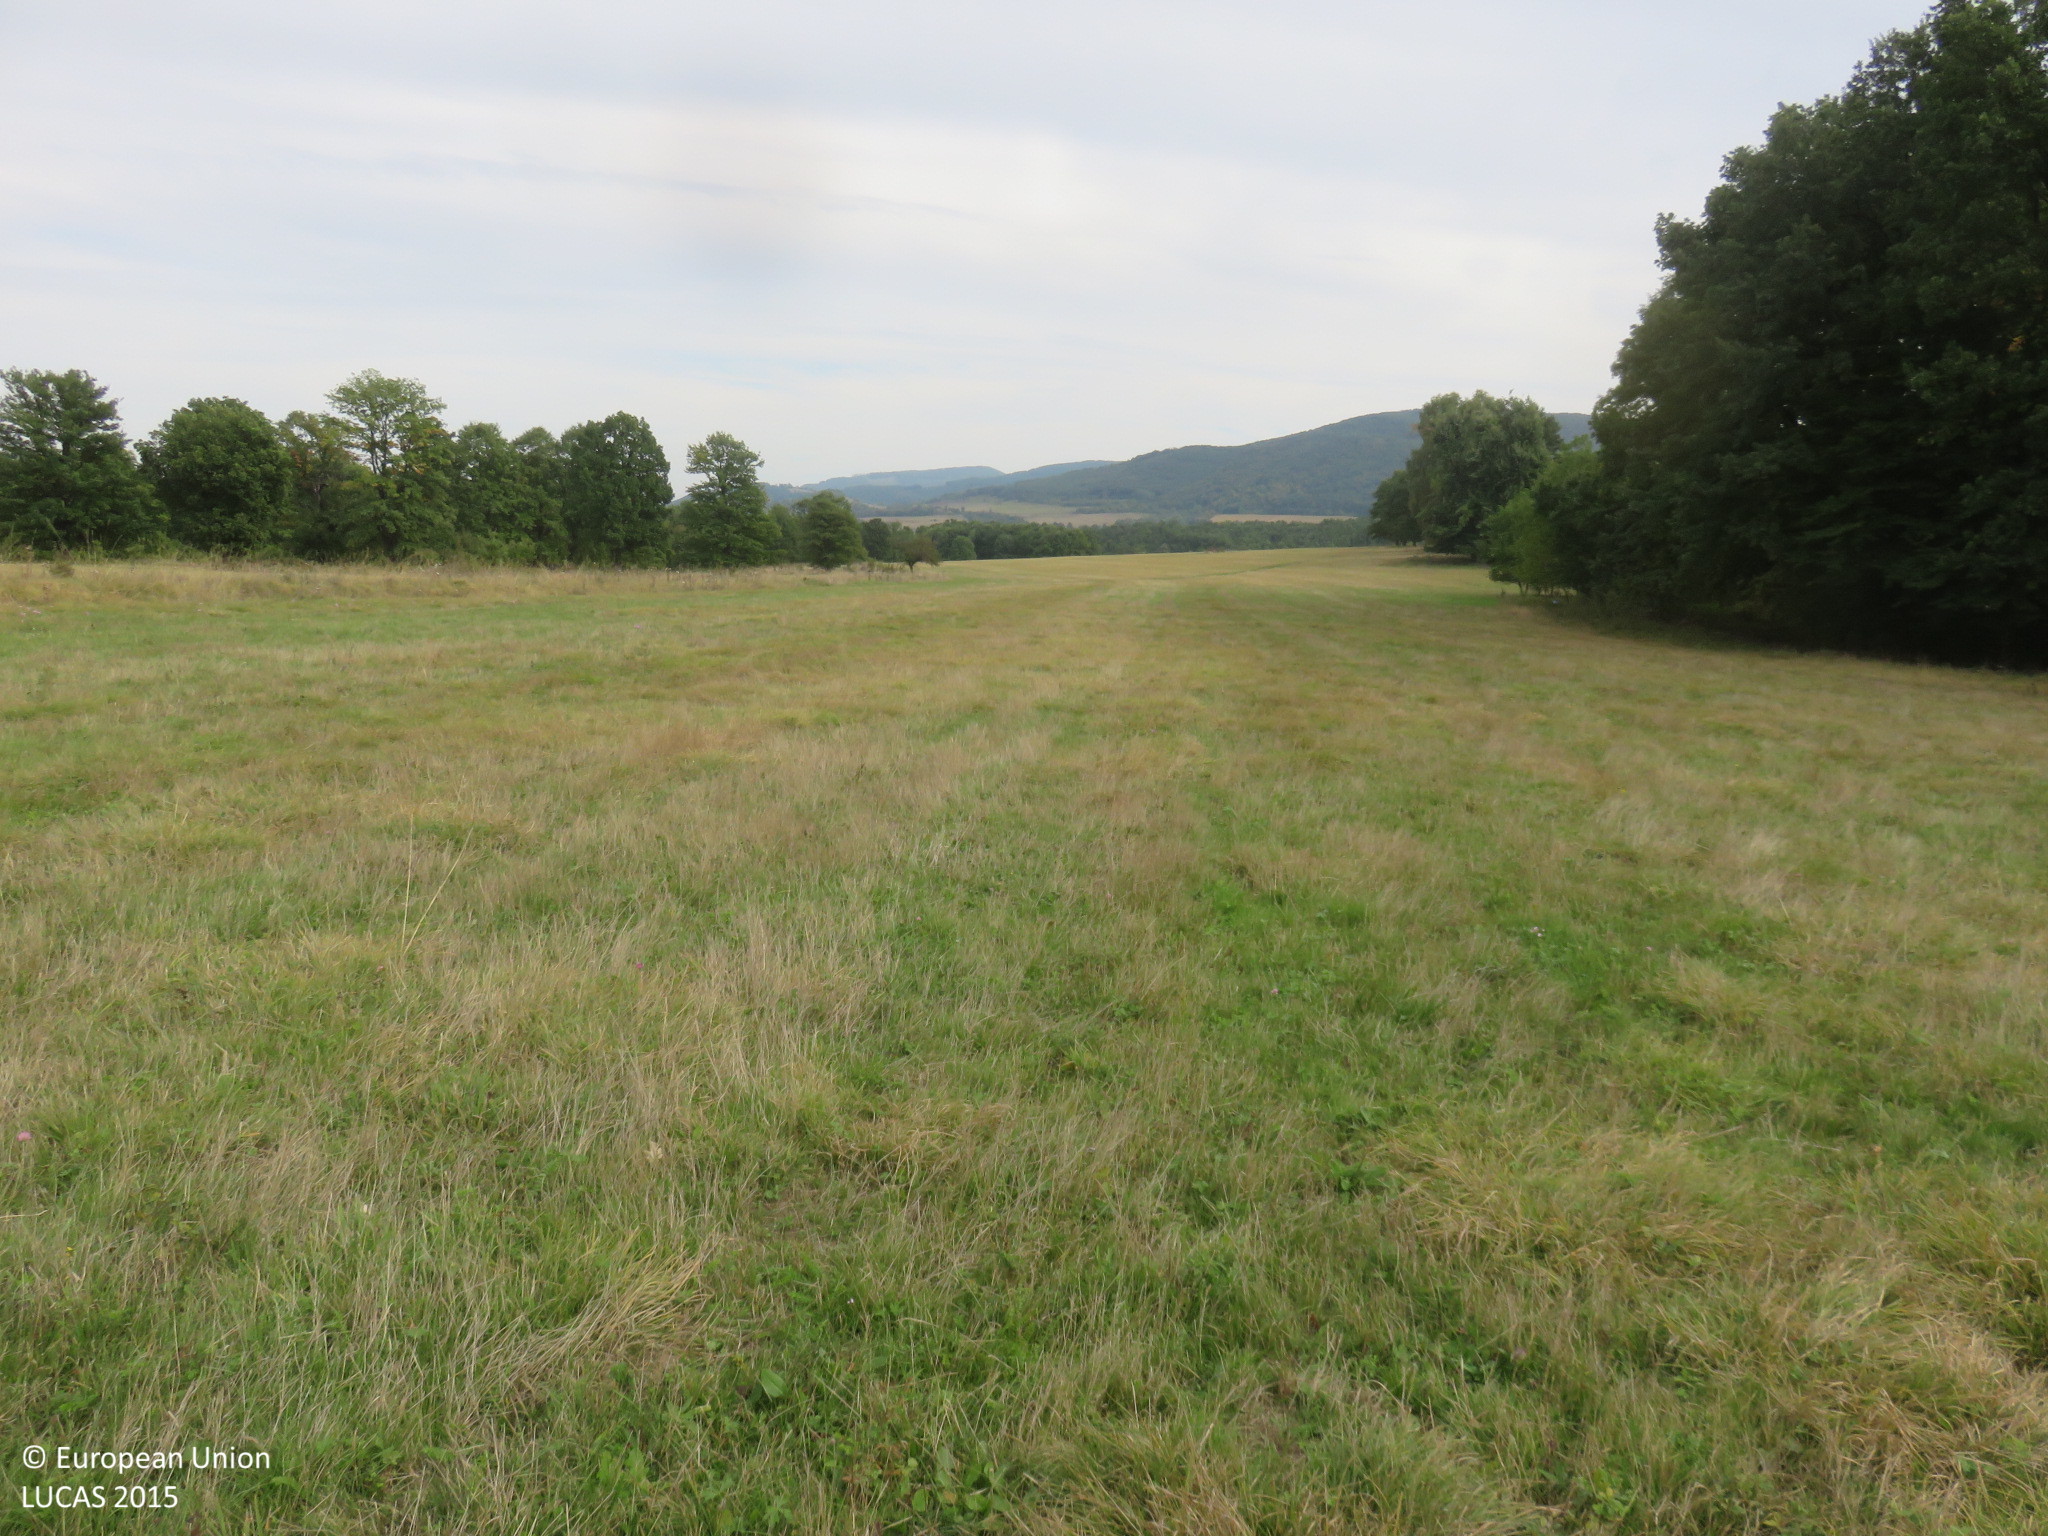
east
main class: Grassland
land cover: Grassland without tree/shrub cover
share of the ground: > 75 %
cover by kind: herbaceous plants 100 %
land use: Agriculture (excluding fallow land and kitchen gardens)
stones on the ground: < 10 %
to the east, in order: Grassland without tree/shrub cover; Tracks; Ditches and canals; Grassland without tree/shrub cover; Grassland with sparse tree/shrub cover; Spontaneously vegetated surfaces
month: October
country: BG
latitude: 43.0399
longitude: 24.8294
